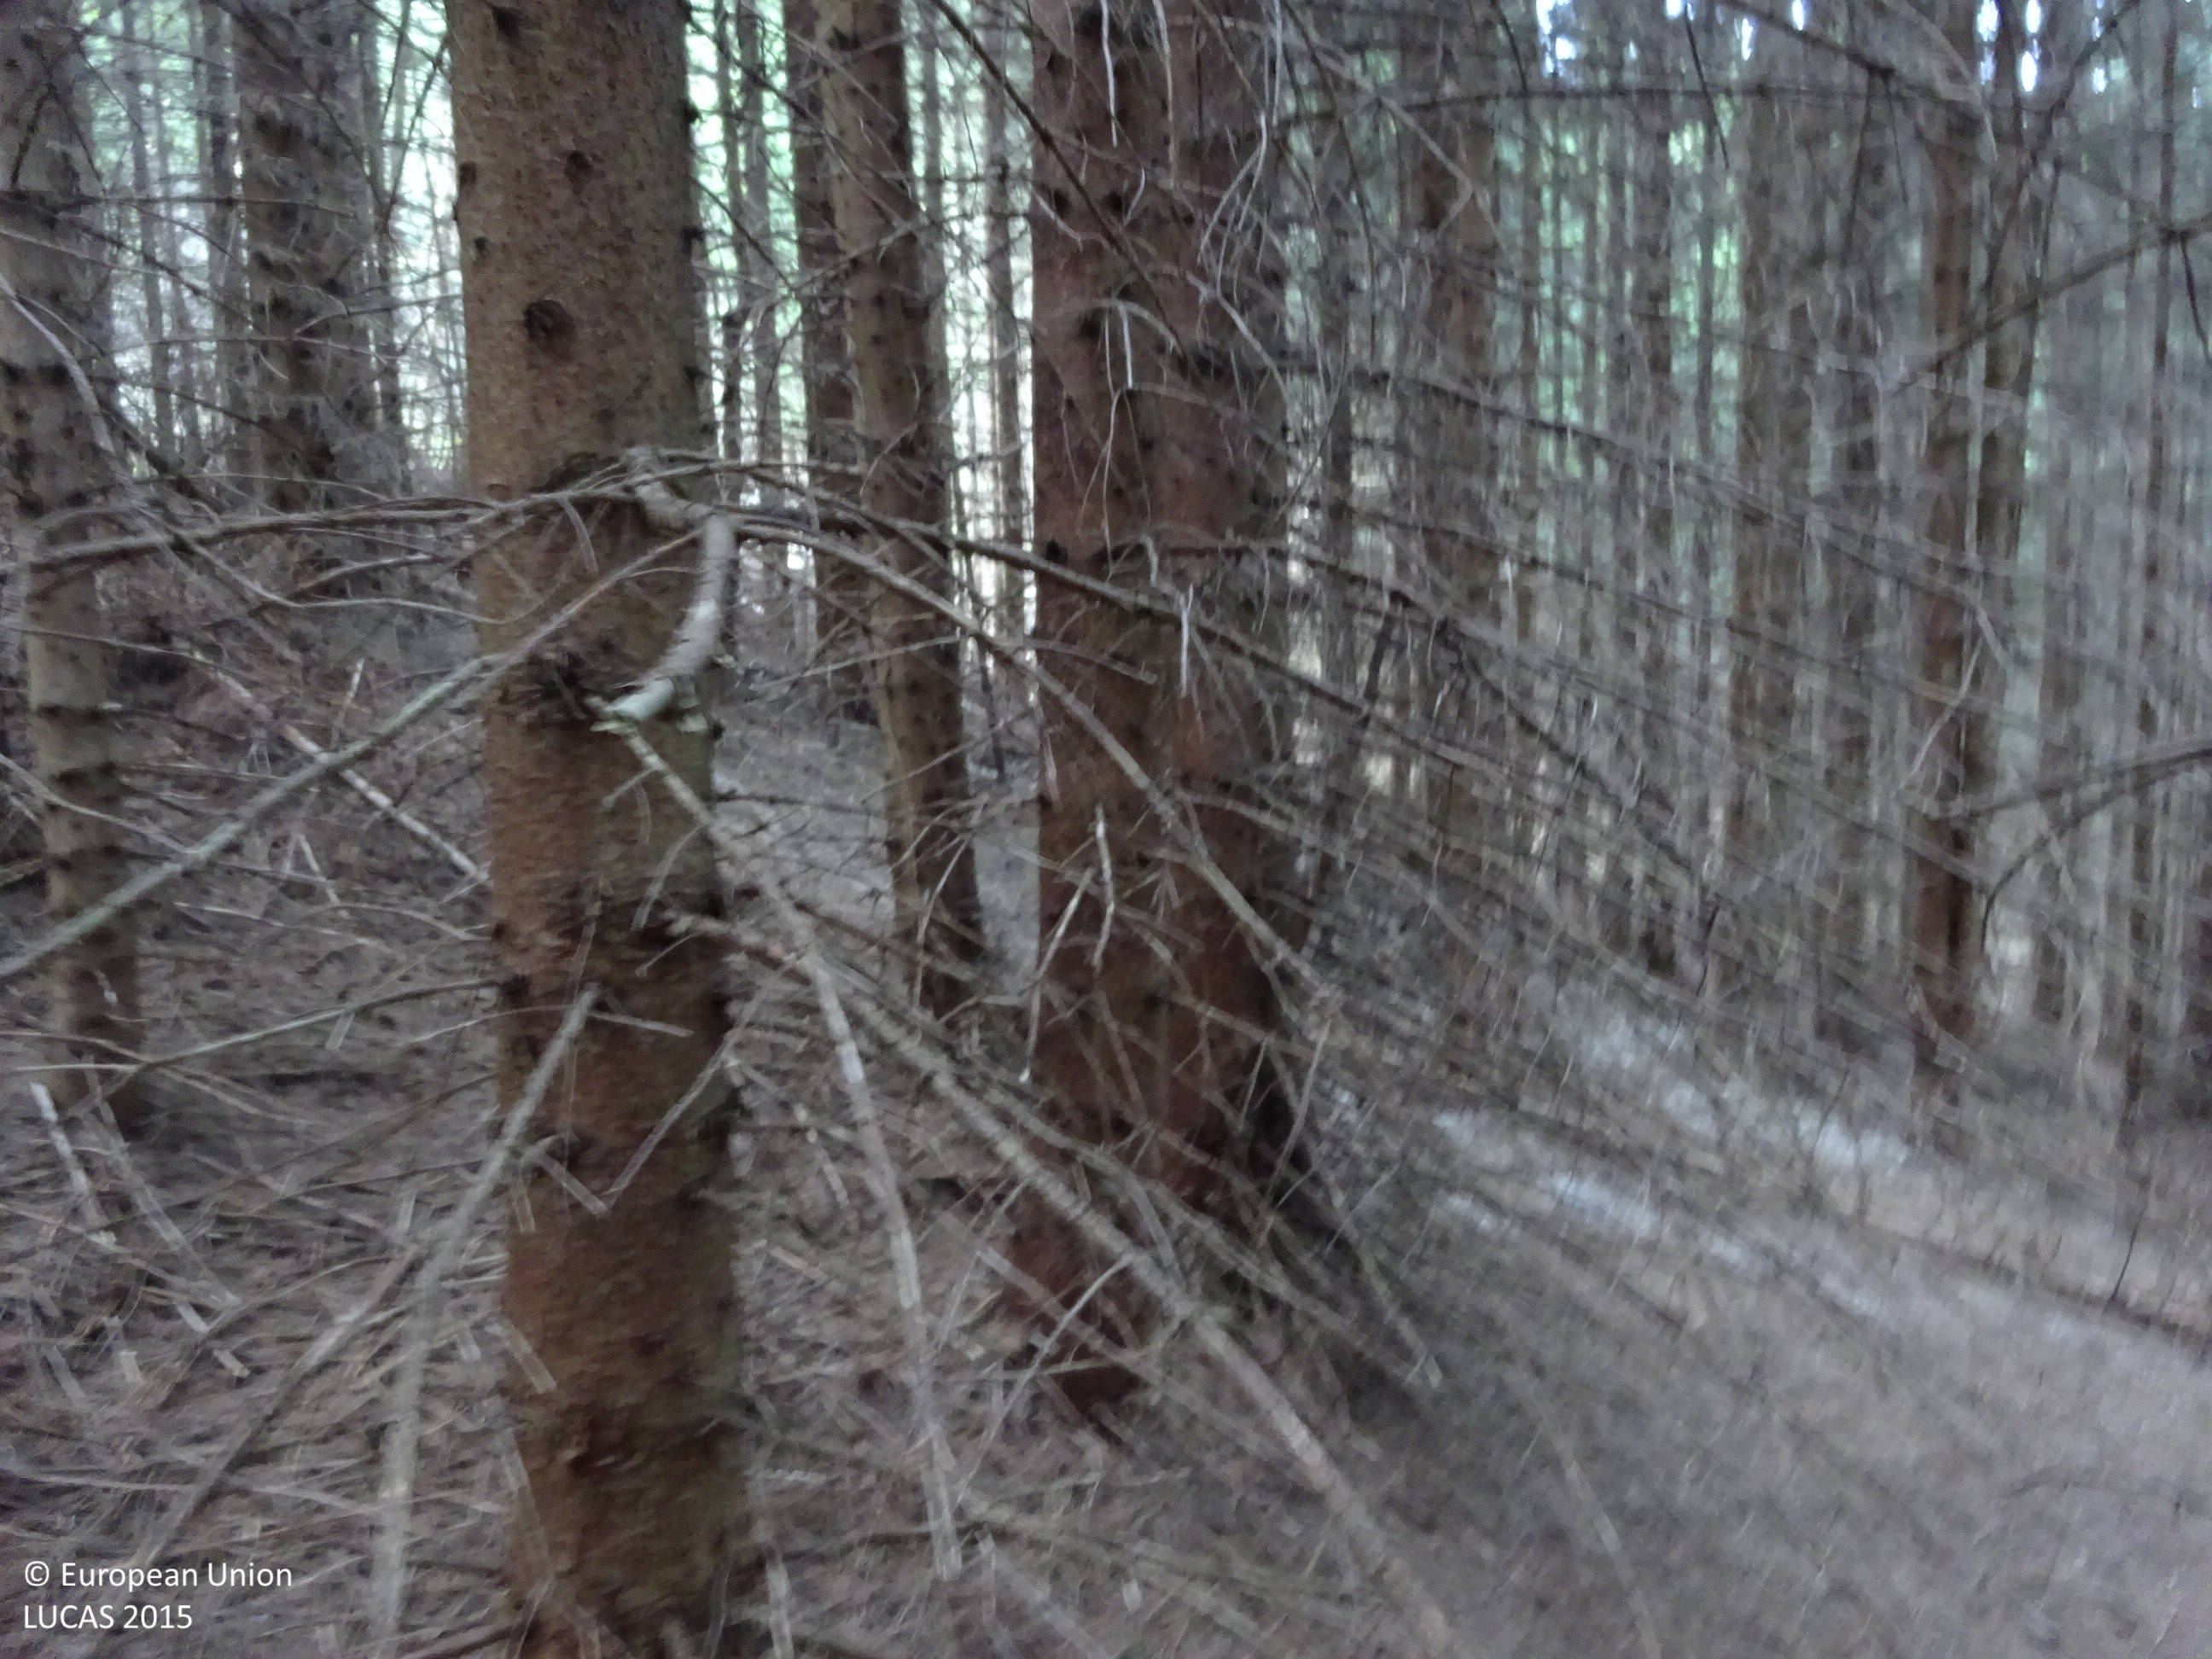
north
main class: Woodland
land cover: Spruce dominated coniferous woodland
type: alpine coniferous forest
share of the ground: > 75 %
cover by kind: coniferous forest trees 100 %
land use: Forestry
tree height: > 5 m
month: August
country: AT
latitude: 47.5551
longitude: 15.9957
